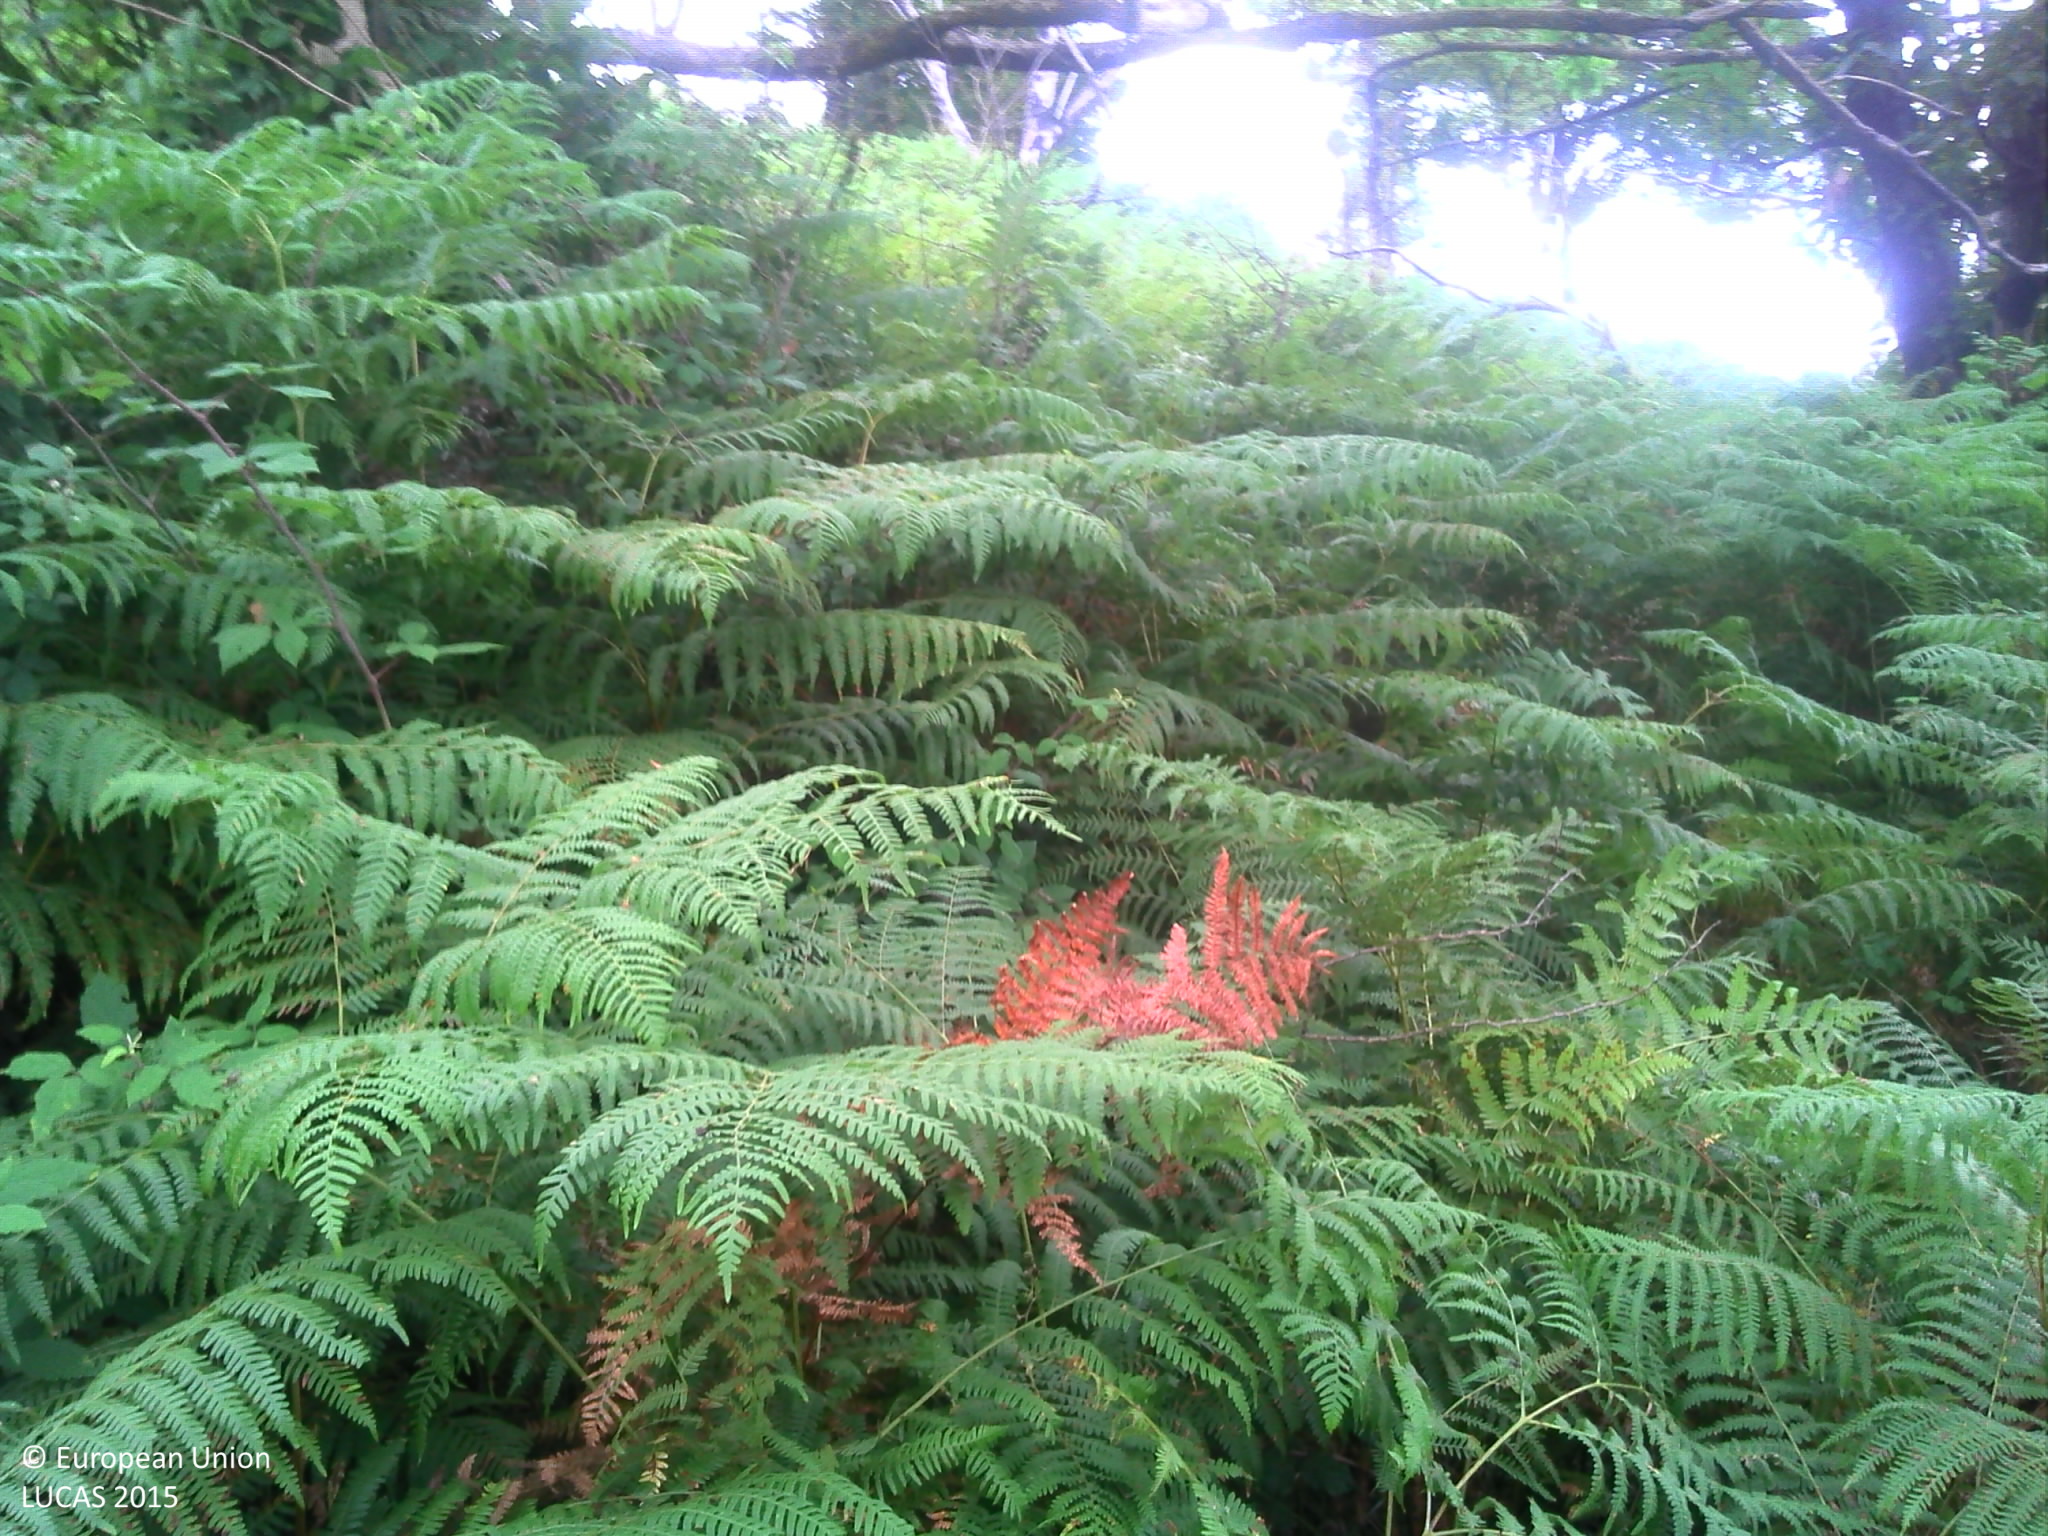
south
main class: Woodland
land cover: Broadleaved woodland
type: thermophilous deciduous forest
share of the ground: > 75 %
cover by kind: broadleaved forest trees 95 %, shrubs 5 %
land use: Forestry
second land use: Agriculture (excluding fallow land and kitchen gardens)
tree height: > 5 m
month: August
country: FR
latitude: 43.2400
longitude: -1.1332
